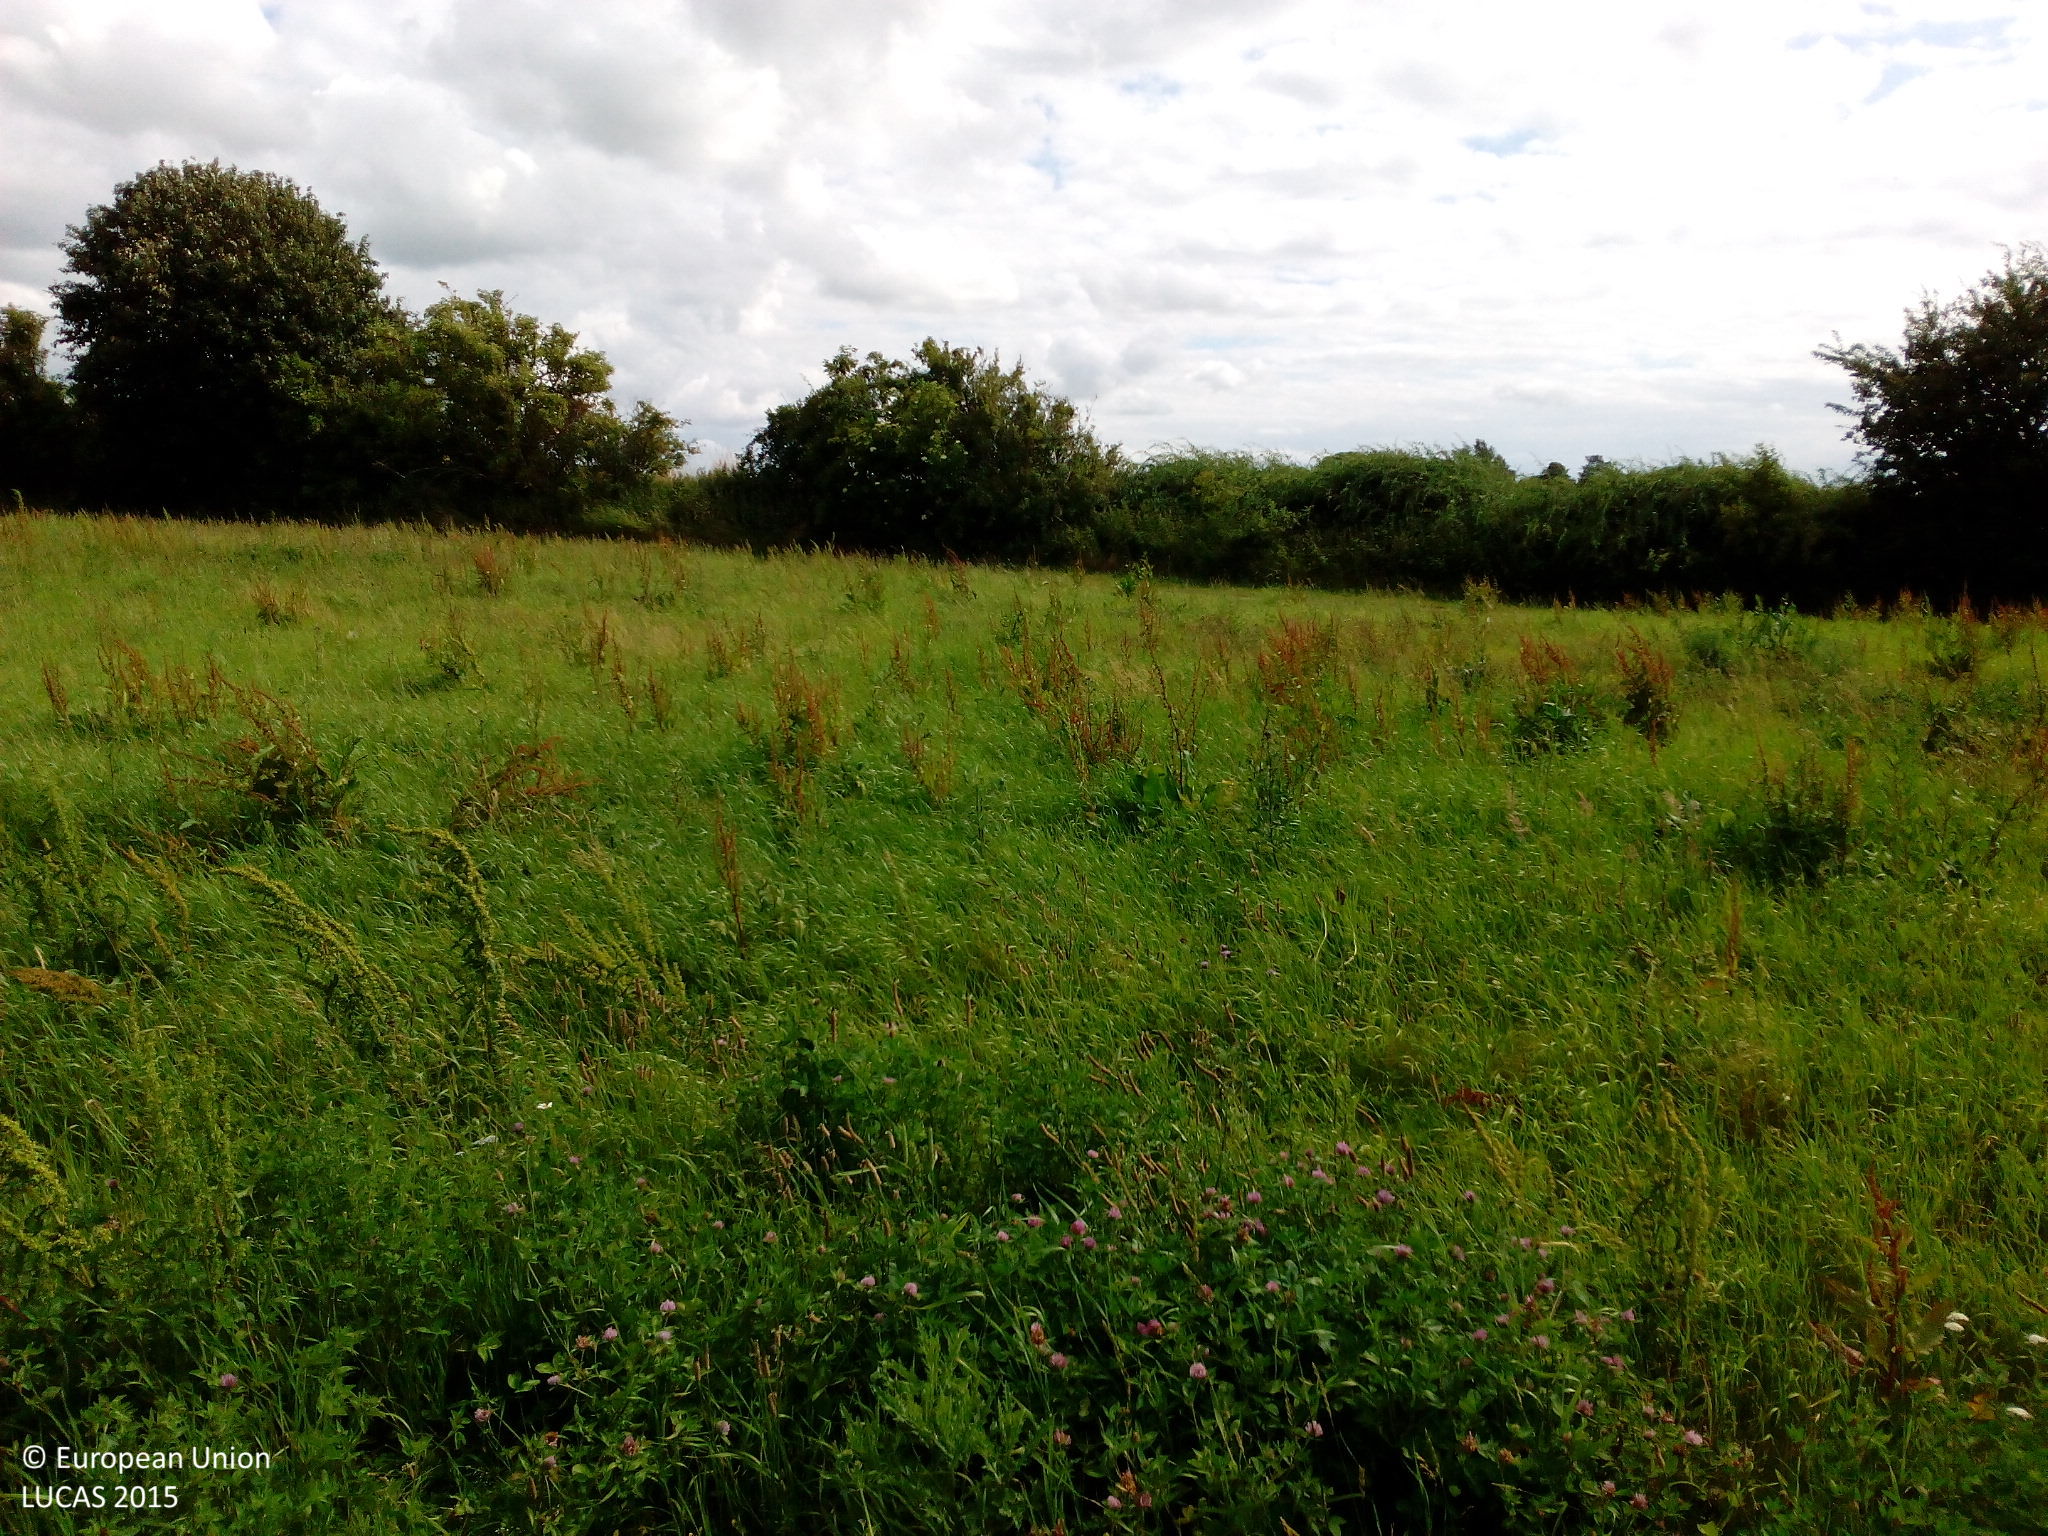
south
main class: Grassland
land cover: Grassland without tree/shrub cover
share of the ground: > 75 %
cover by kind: herbaceous plants 100 %
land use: Amenities, museums, leisure
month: July
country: DK
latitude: 55.7495
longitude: 11.3210
